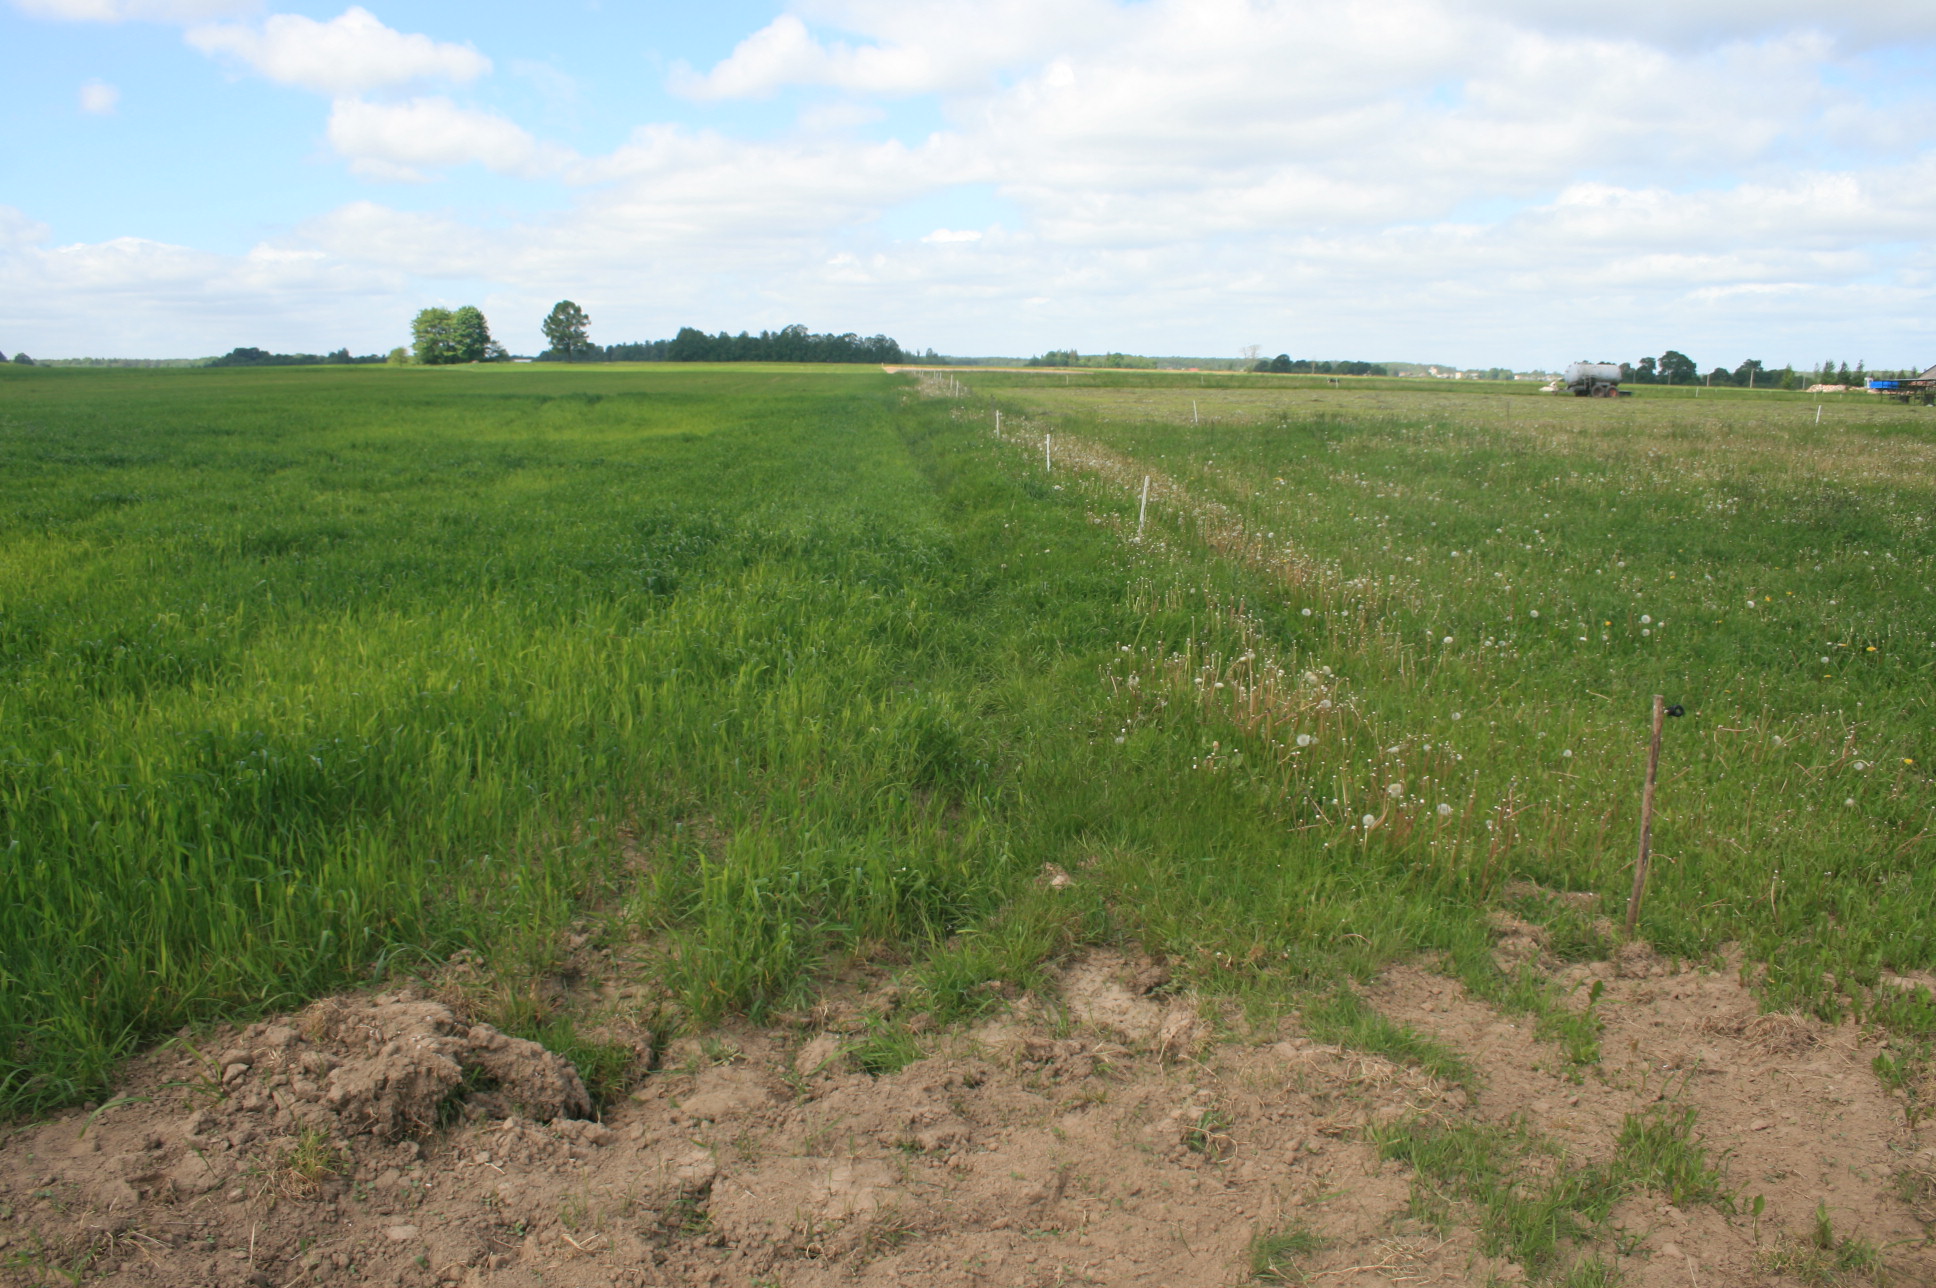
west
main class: Cropland
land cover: Other leguminous and mixtures for fodder
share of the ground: < 10 %
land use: Agriculture (excluding fallow land and kitchen gardens)
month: June
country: LT
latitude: 56.1893
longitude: 22.3508
